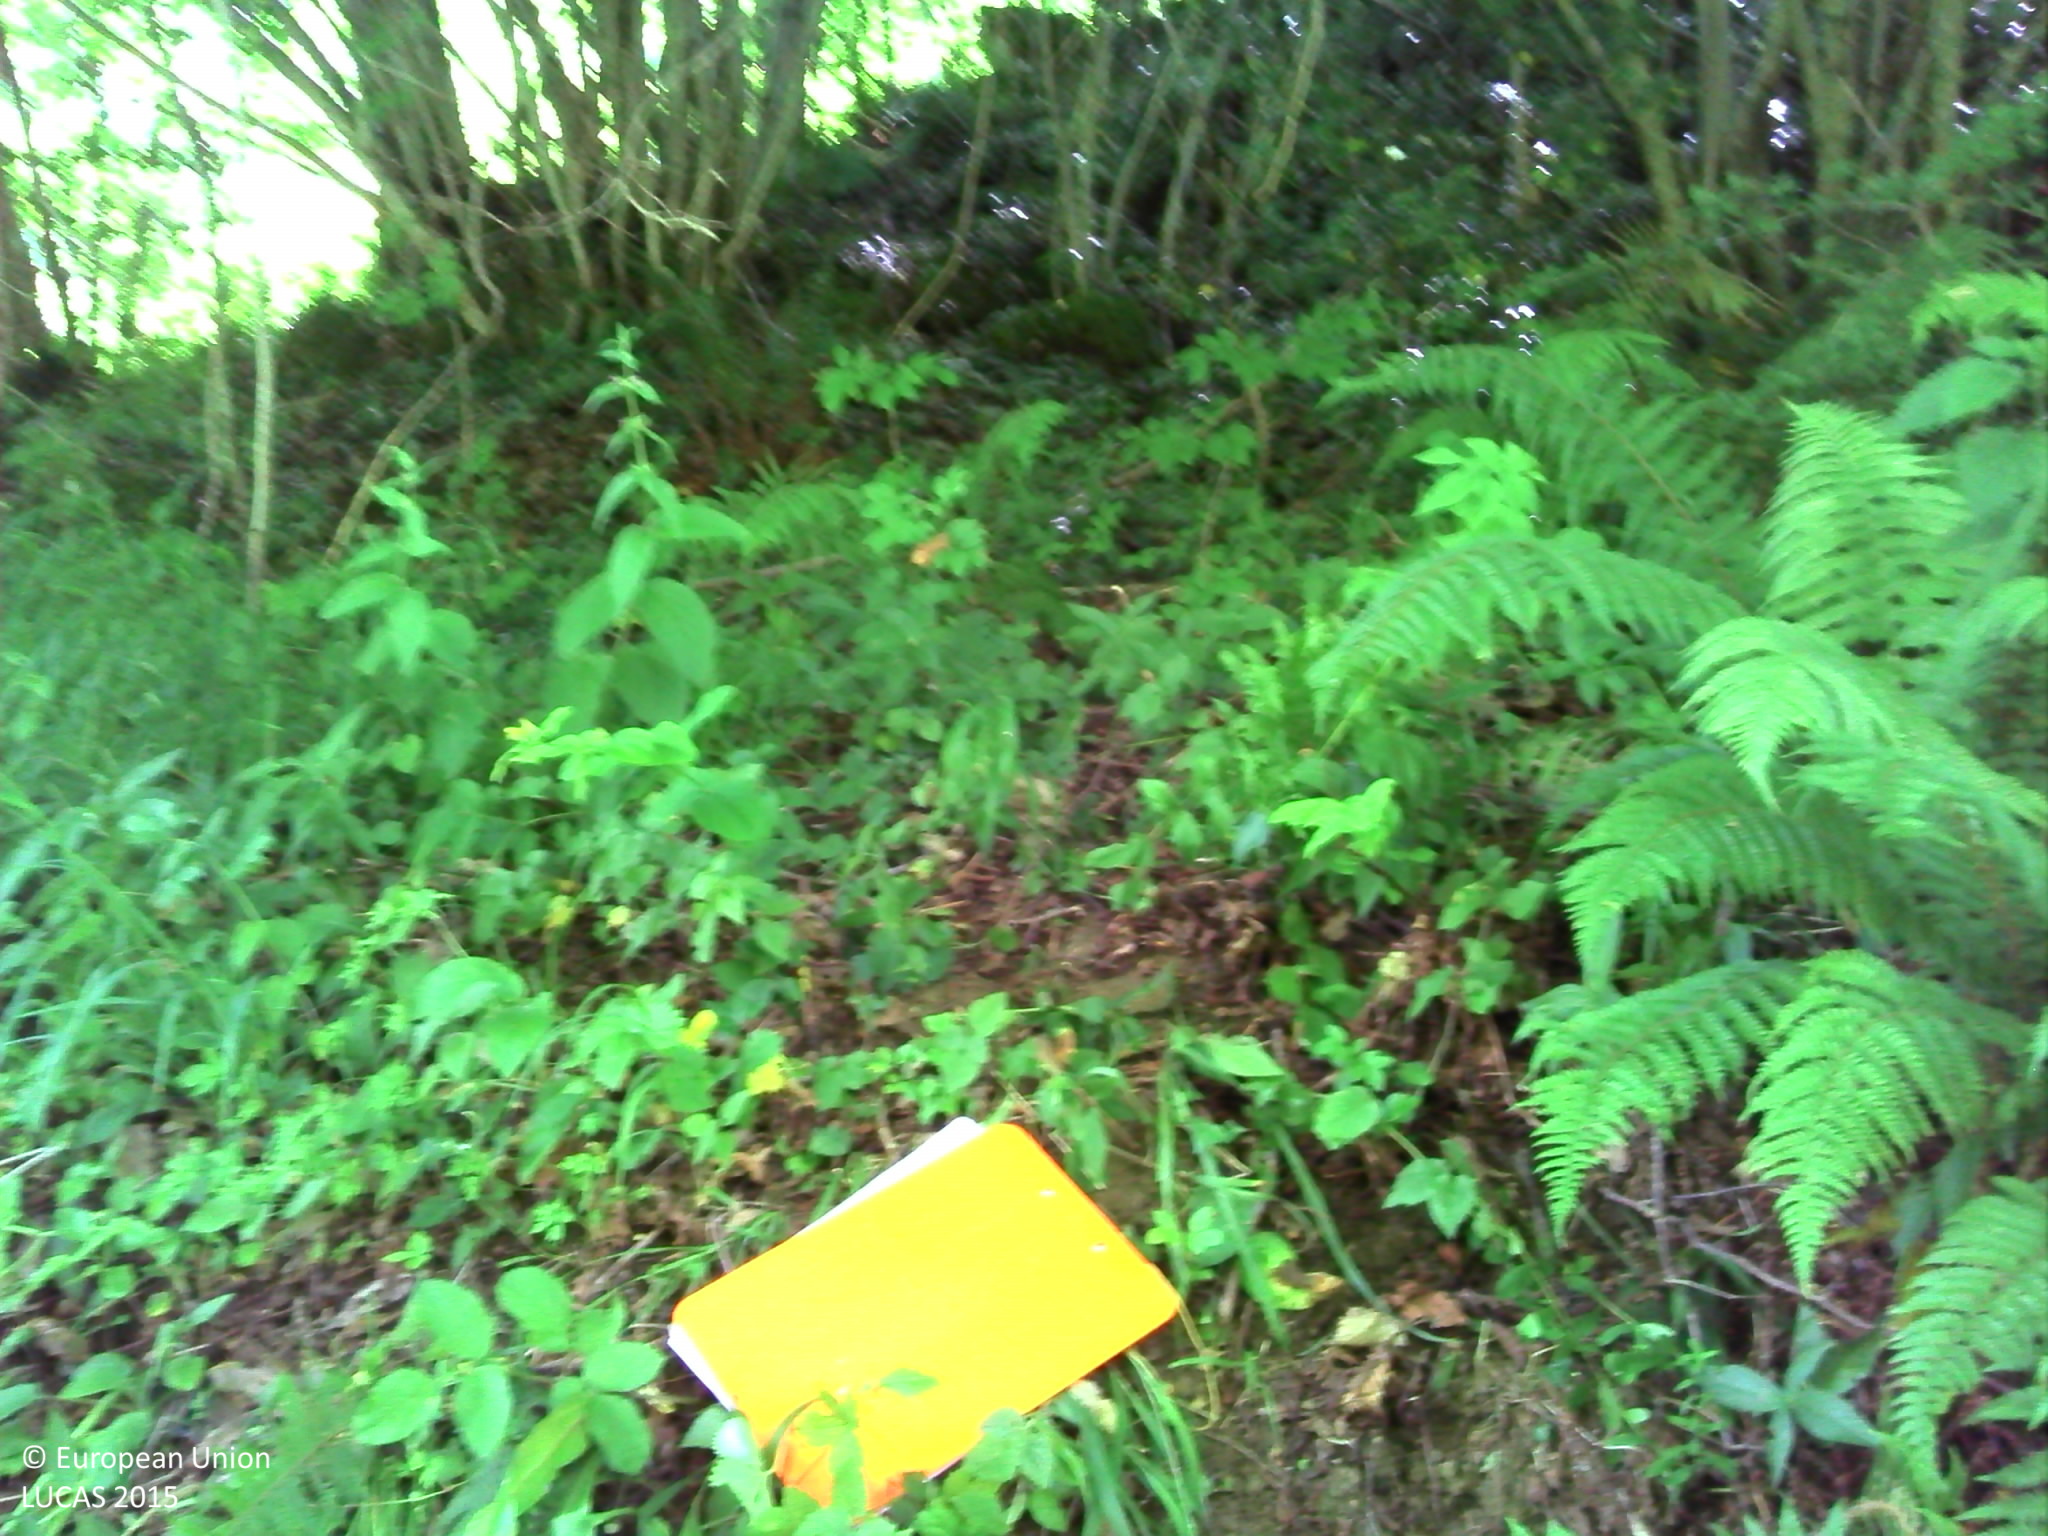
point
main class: Woodland
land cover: Broadleaved woodland
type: mesophytic deciduous forest
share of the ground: > 75 %
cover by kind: broadleaved forest trees 50 %, consolidated bare surface 30 %, shrubs 10 %, herbaceous plants 10 %
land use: Forestry
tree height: > 5 m
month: July
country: FR
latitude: 42.9695
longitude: 0.8940
